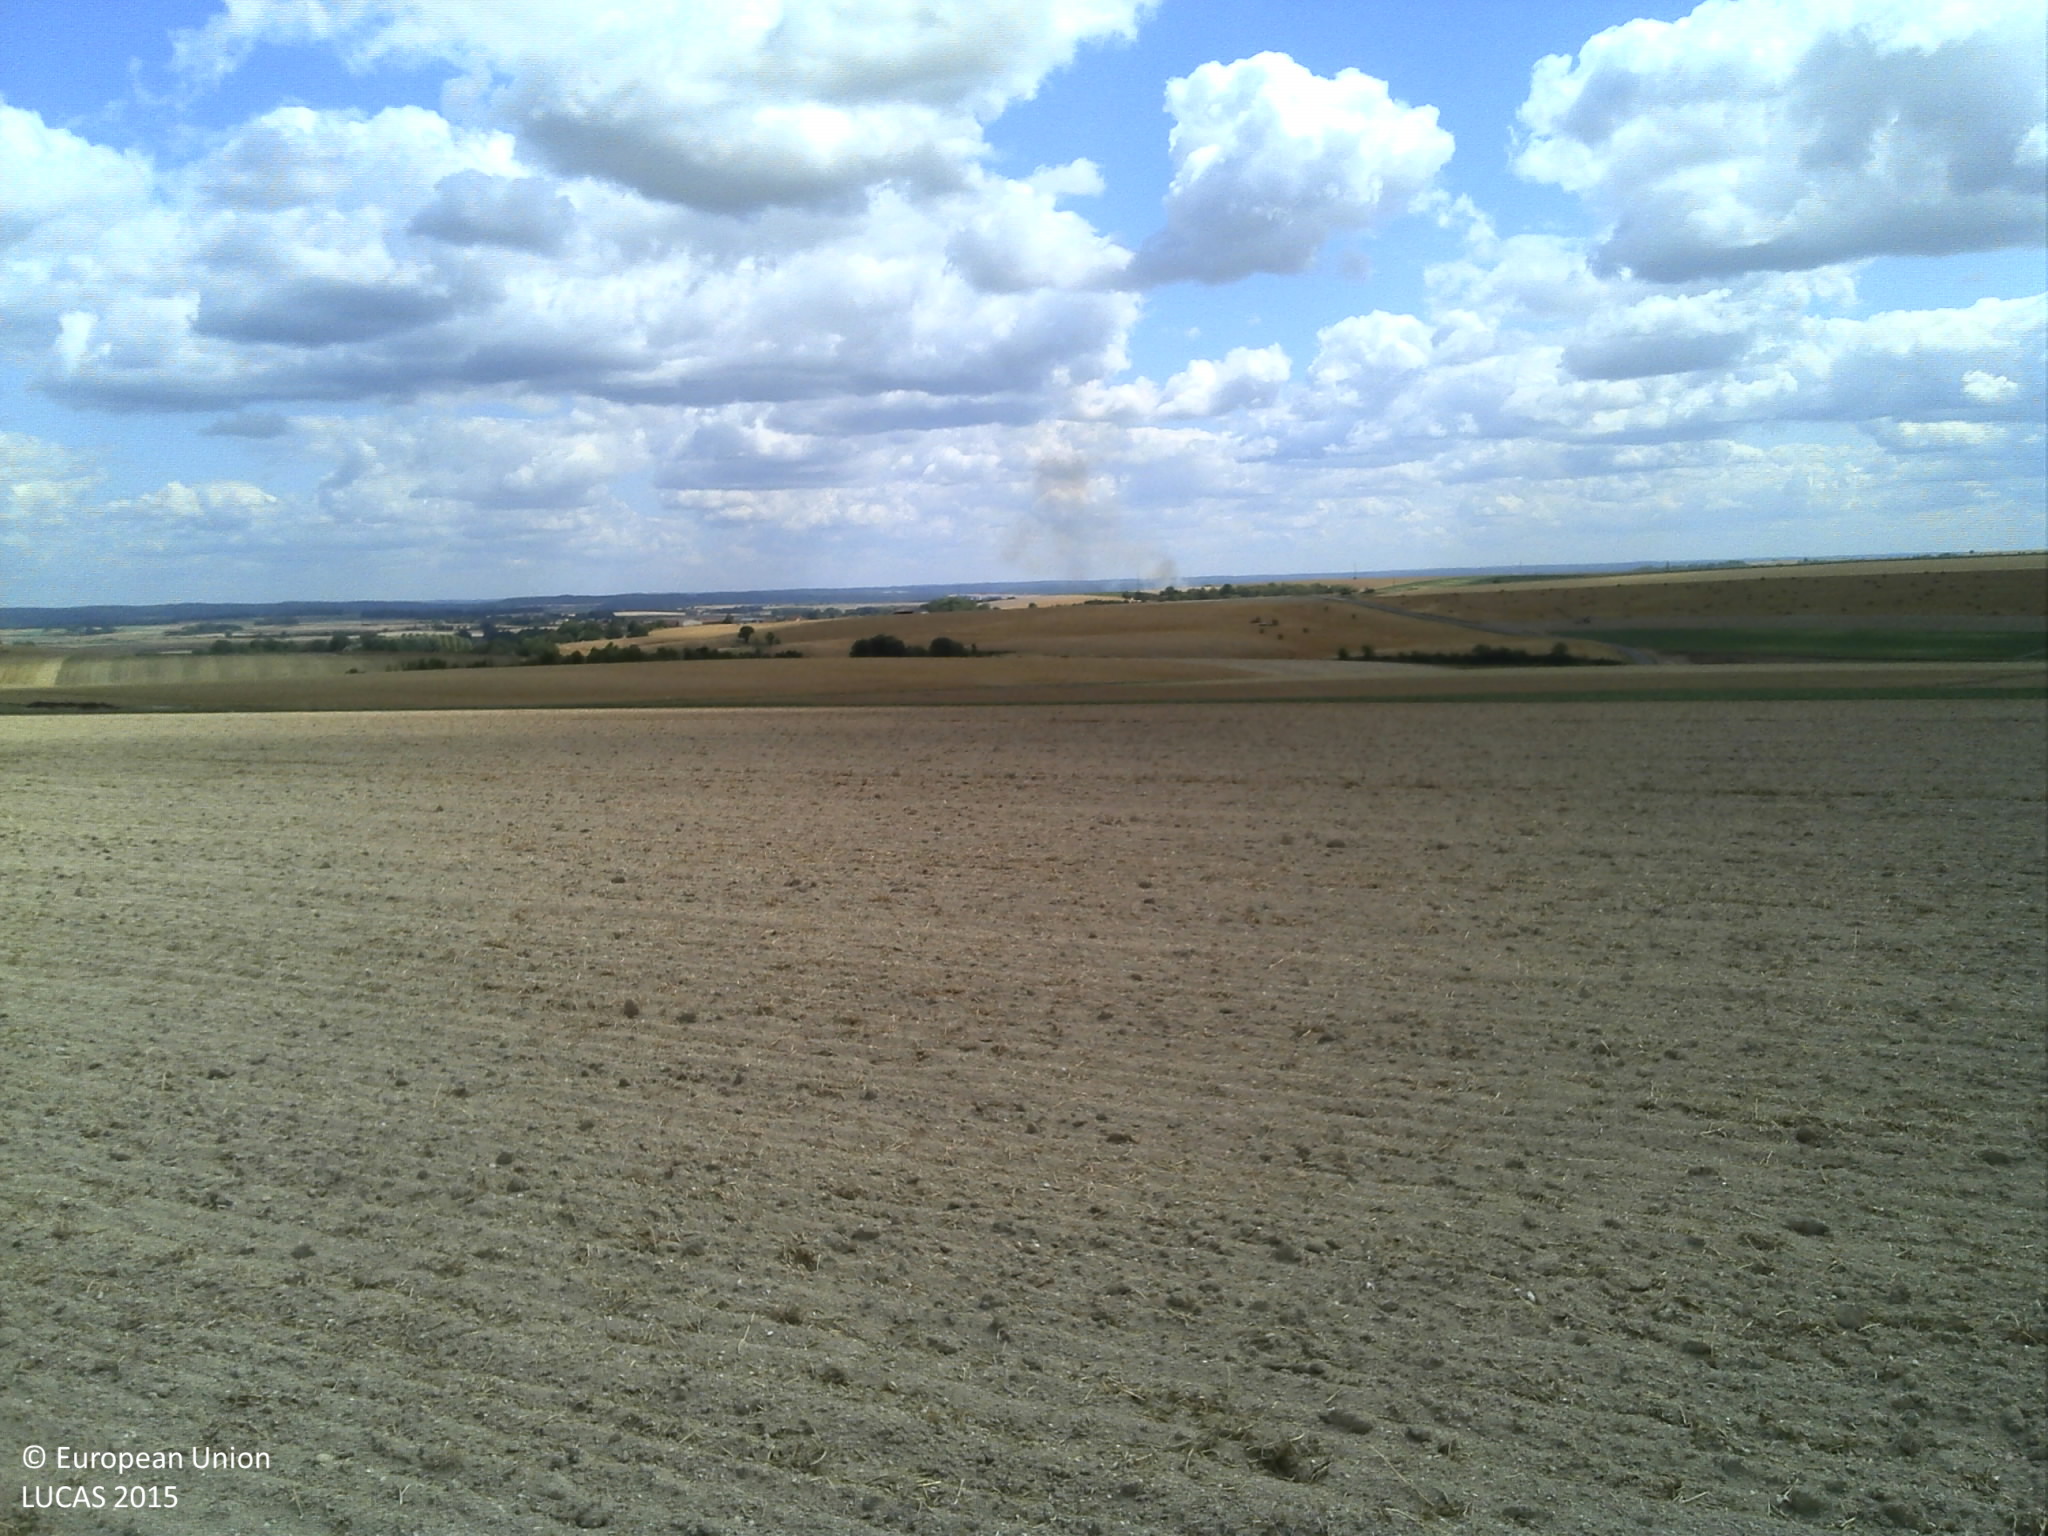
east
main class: Cropland
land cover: Dry pulses
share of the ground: < 10 %
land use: Agriculture (excluding fallow land and kitchen gardens)
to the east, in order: Dry pulses; Sugar beet
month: July
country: FR
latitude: 49.3361
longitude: 4.6158
